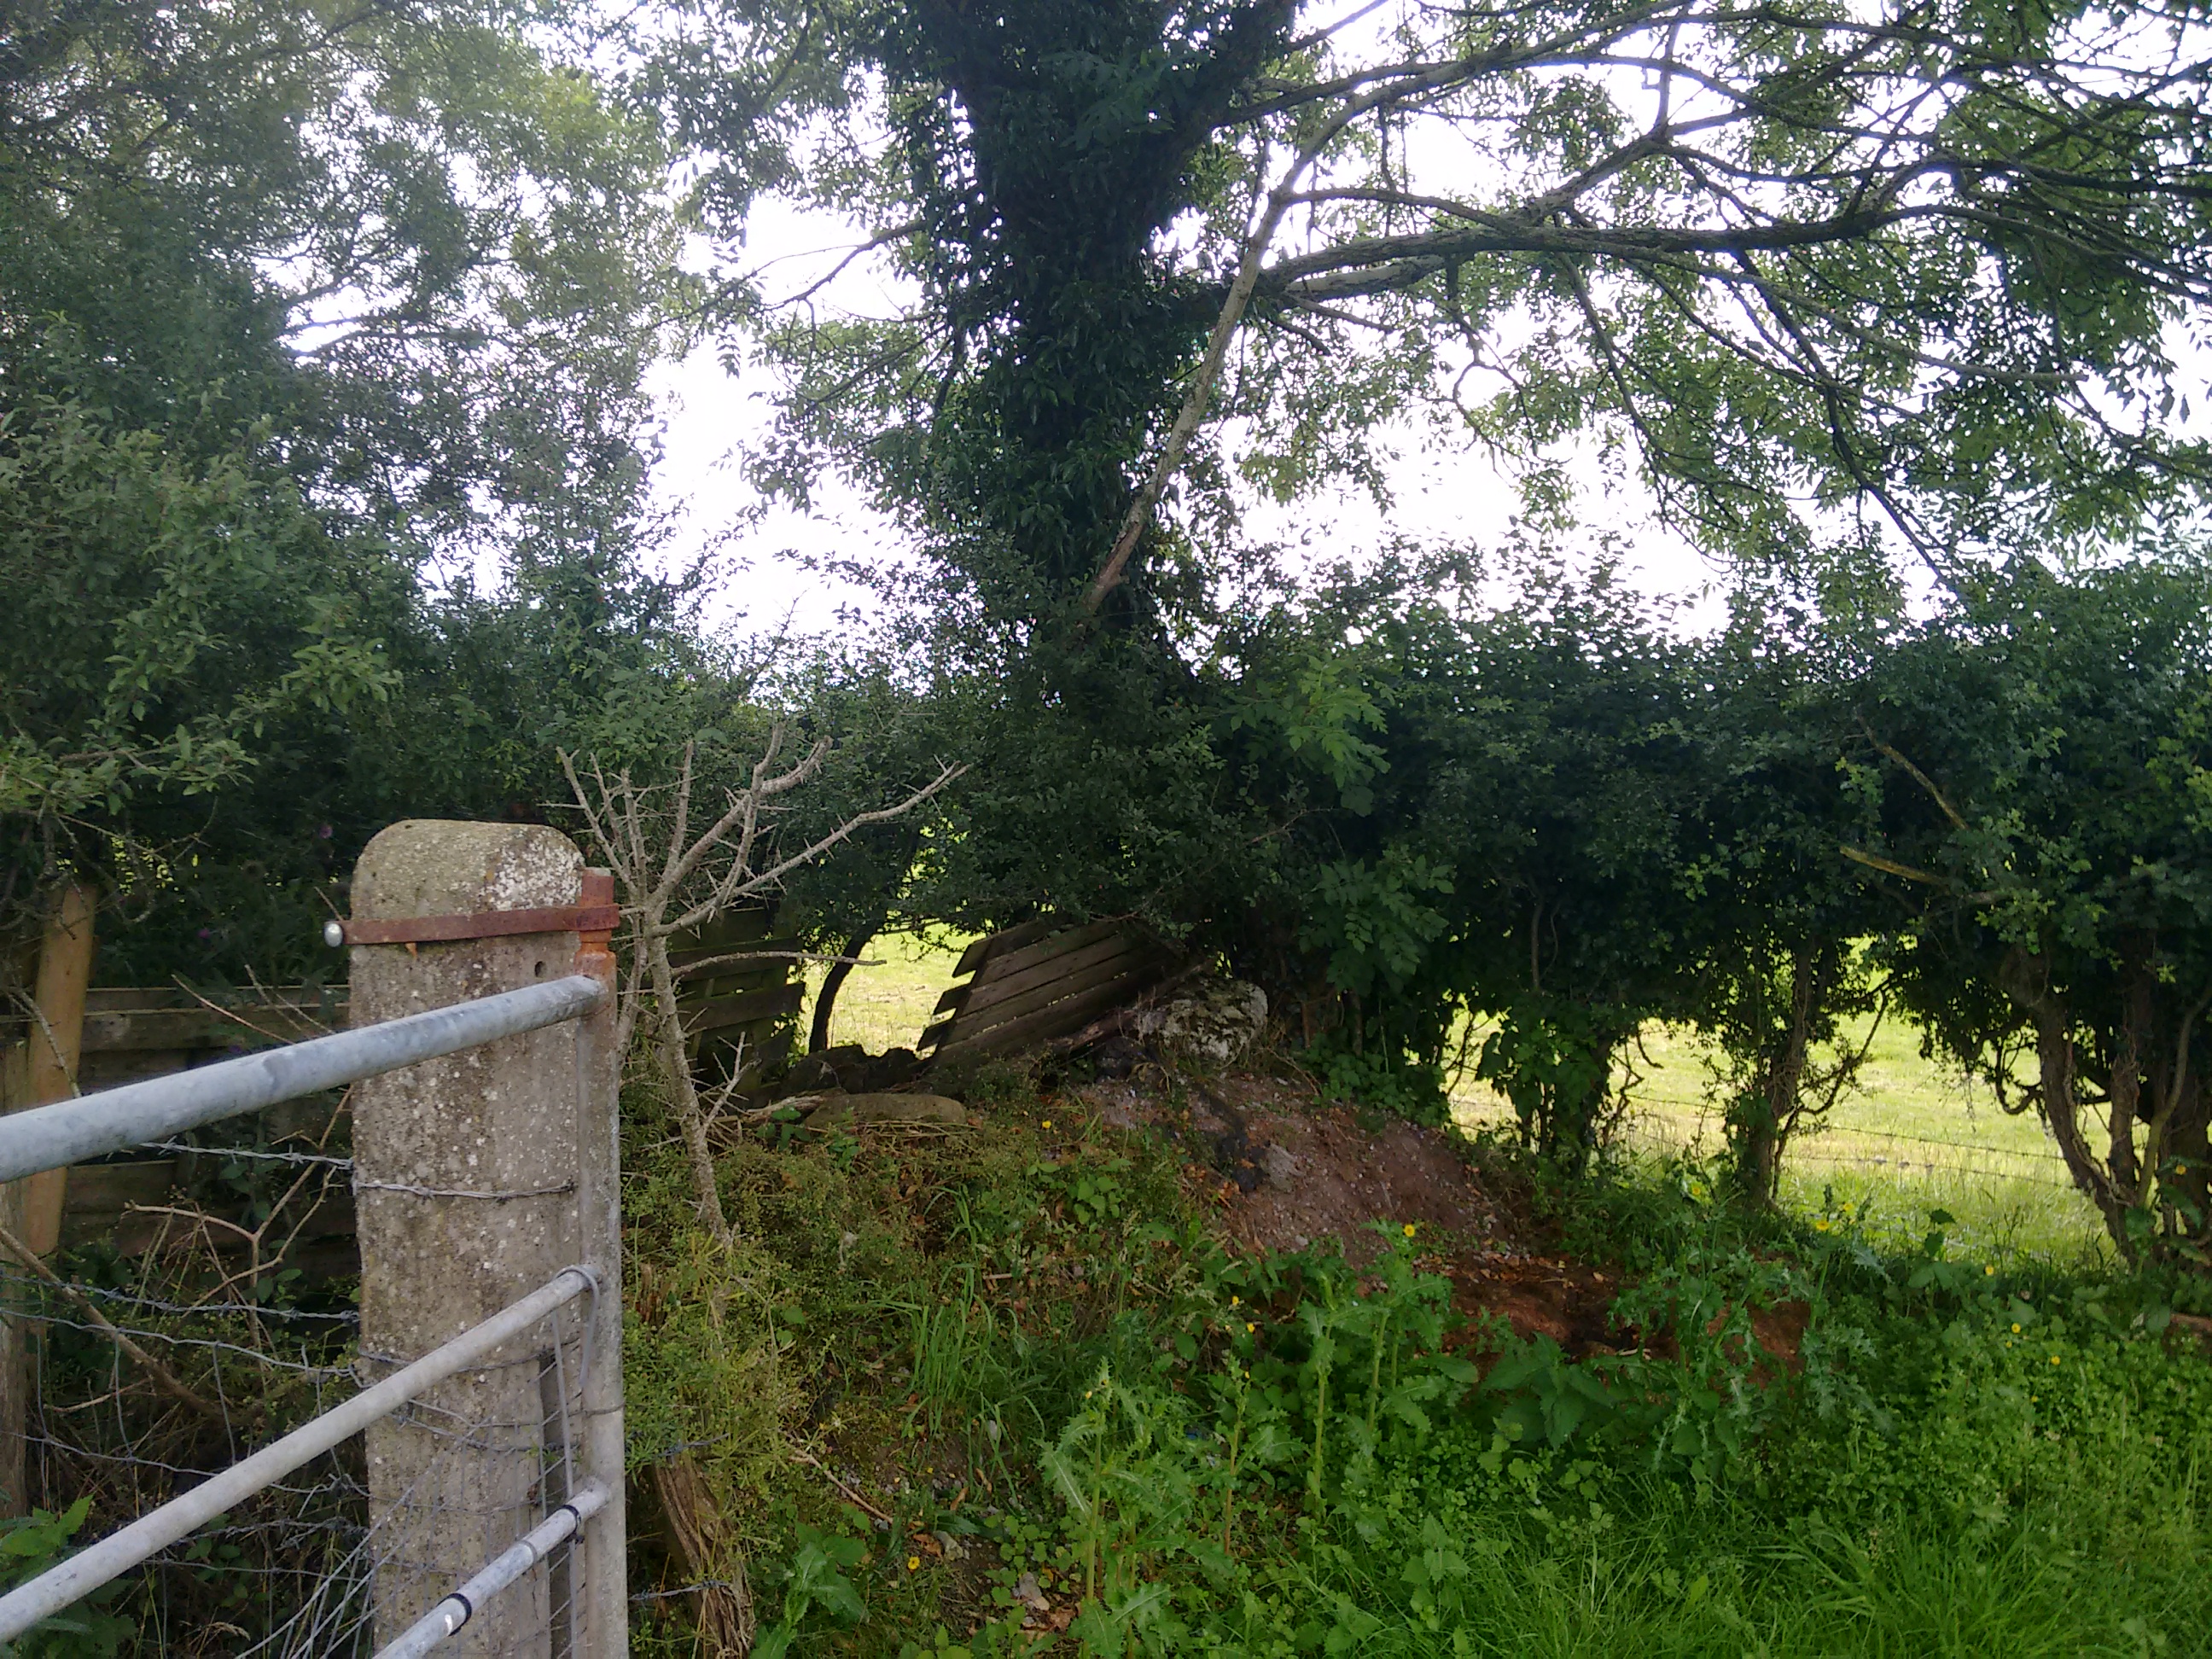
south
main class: Grassland
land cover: Grassland without tree/shrub cover
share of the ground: > 75 %
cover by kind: herbaceous plants 100 %
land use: Agriculture (excluding fallow land and kitchen gardens)
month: August
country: GB
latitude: 54.4416
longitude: -6.8019
